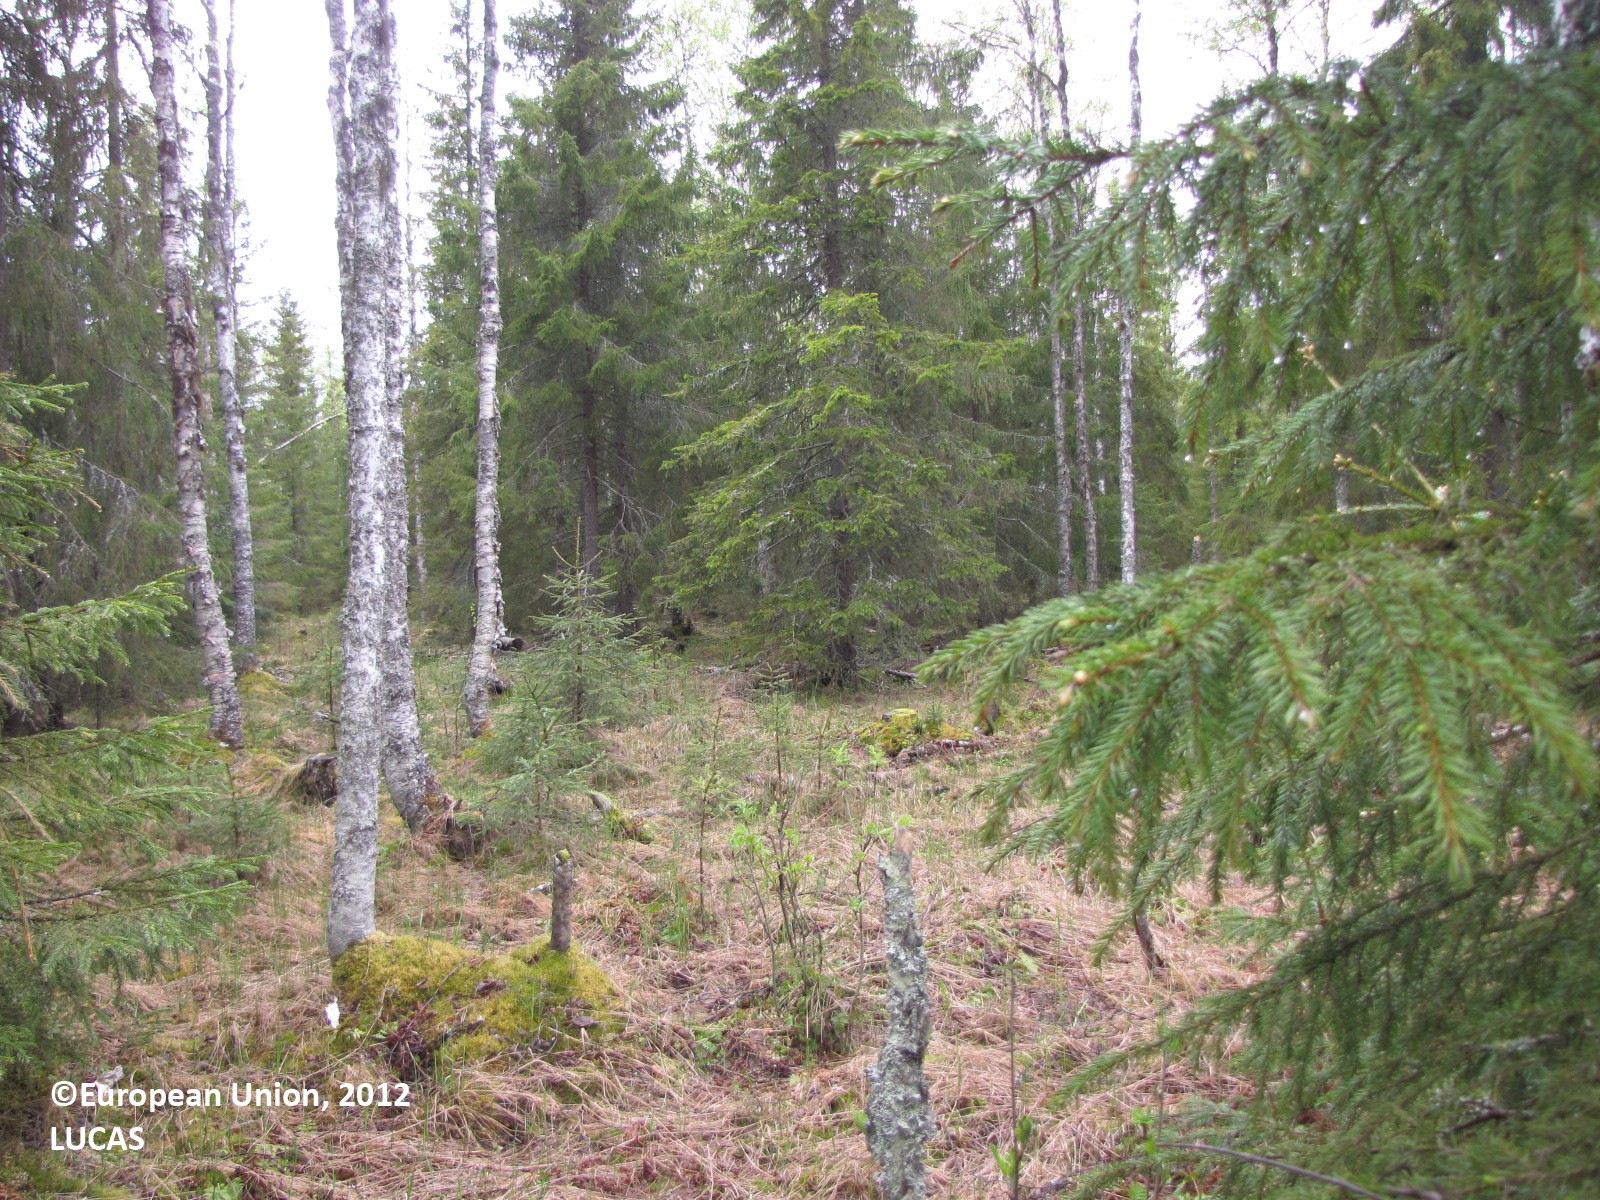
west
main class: Woodland
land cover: Spruce dominated mixed woodland
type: boreal forest
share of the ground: 50 - 75 %
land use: Forestry
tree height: > 5 m
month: June
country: FI
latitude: 65.9640
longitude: 24.2385
